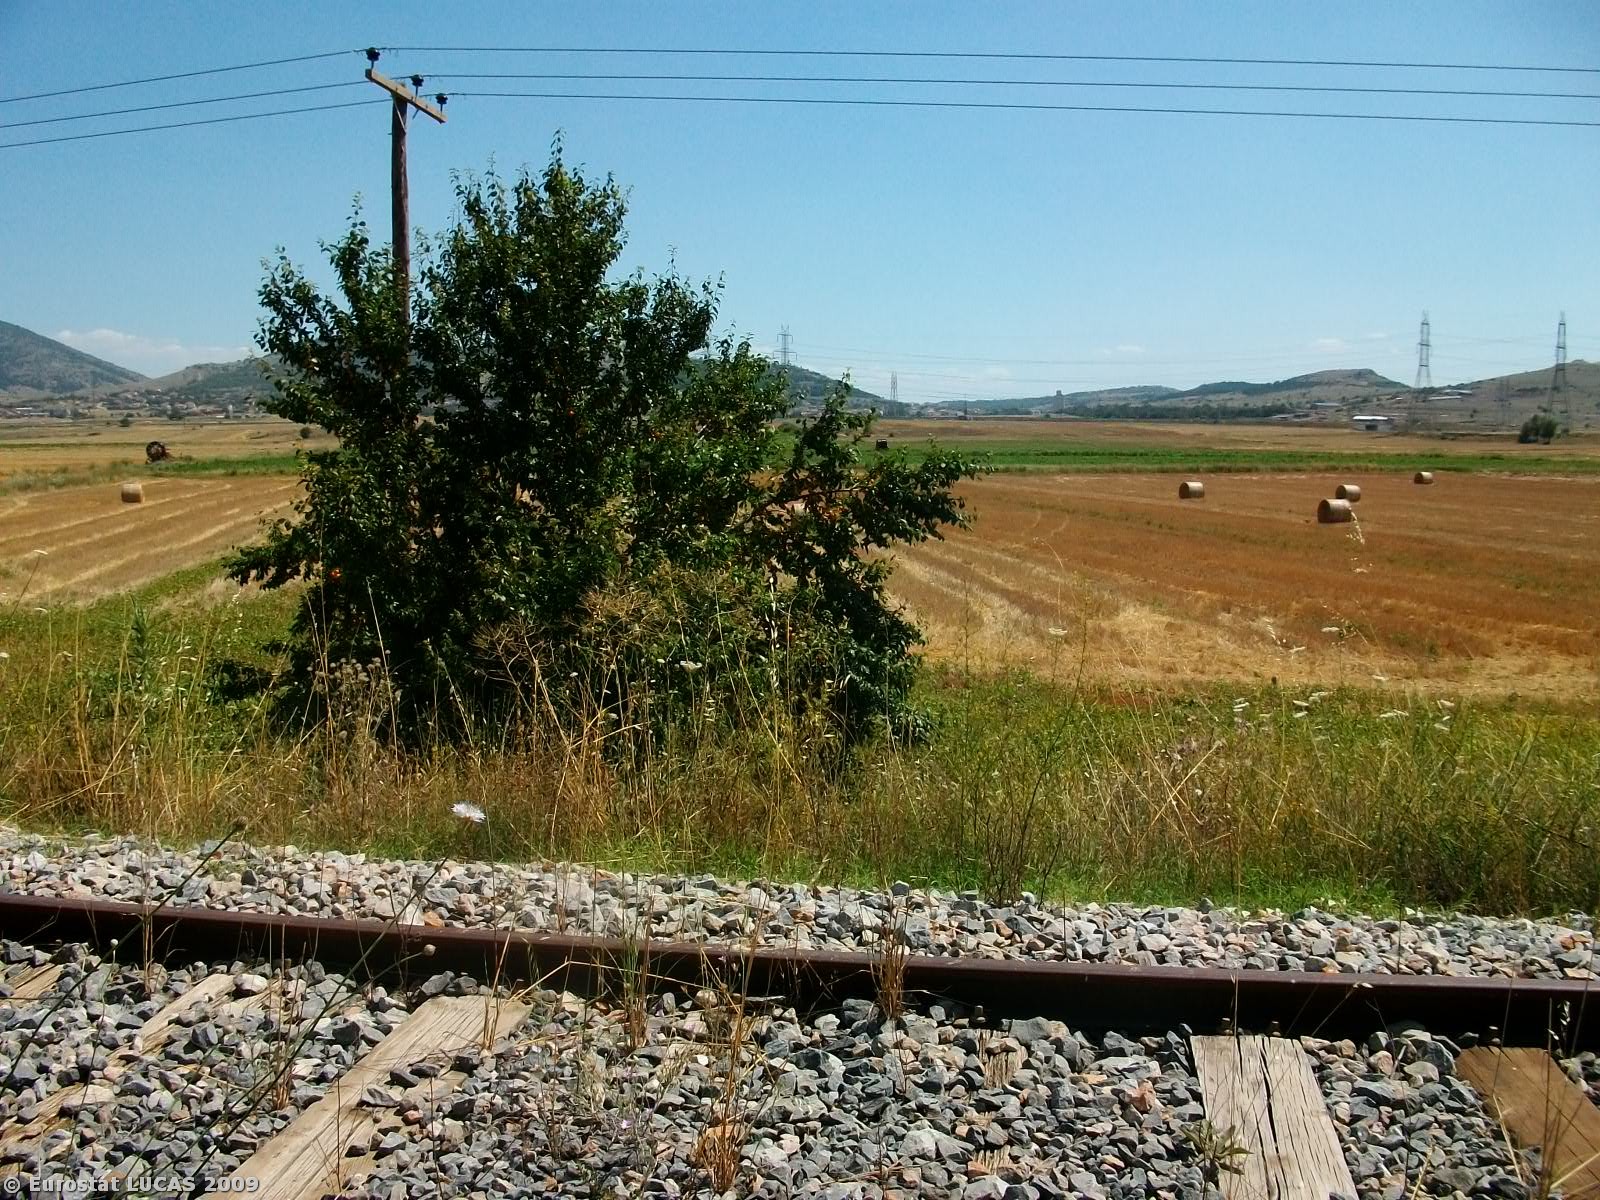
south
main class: Grassland
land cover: Grassland without tree/shrub cover
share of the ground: > 75 %
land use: Unused
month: July
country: GR
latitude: 40.3709
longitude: 21.8291
